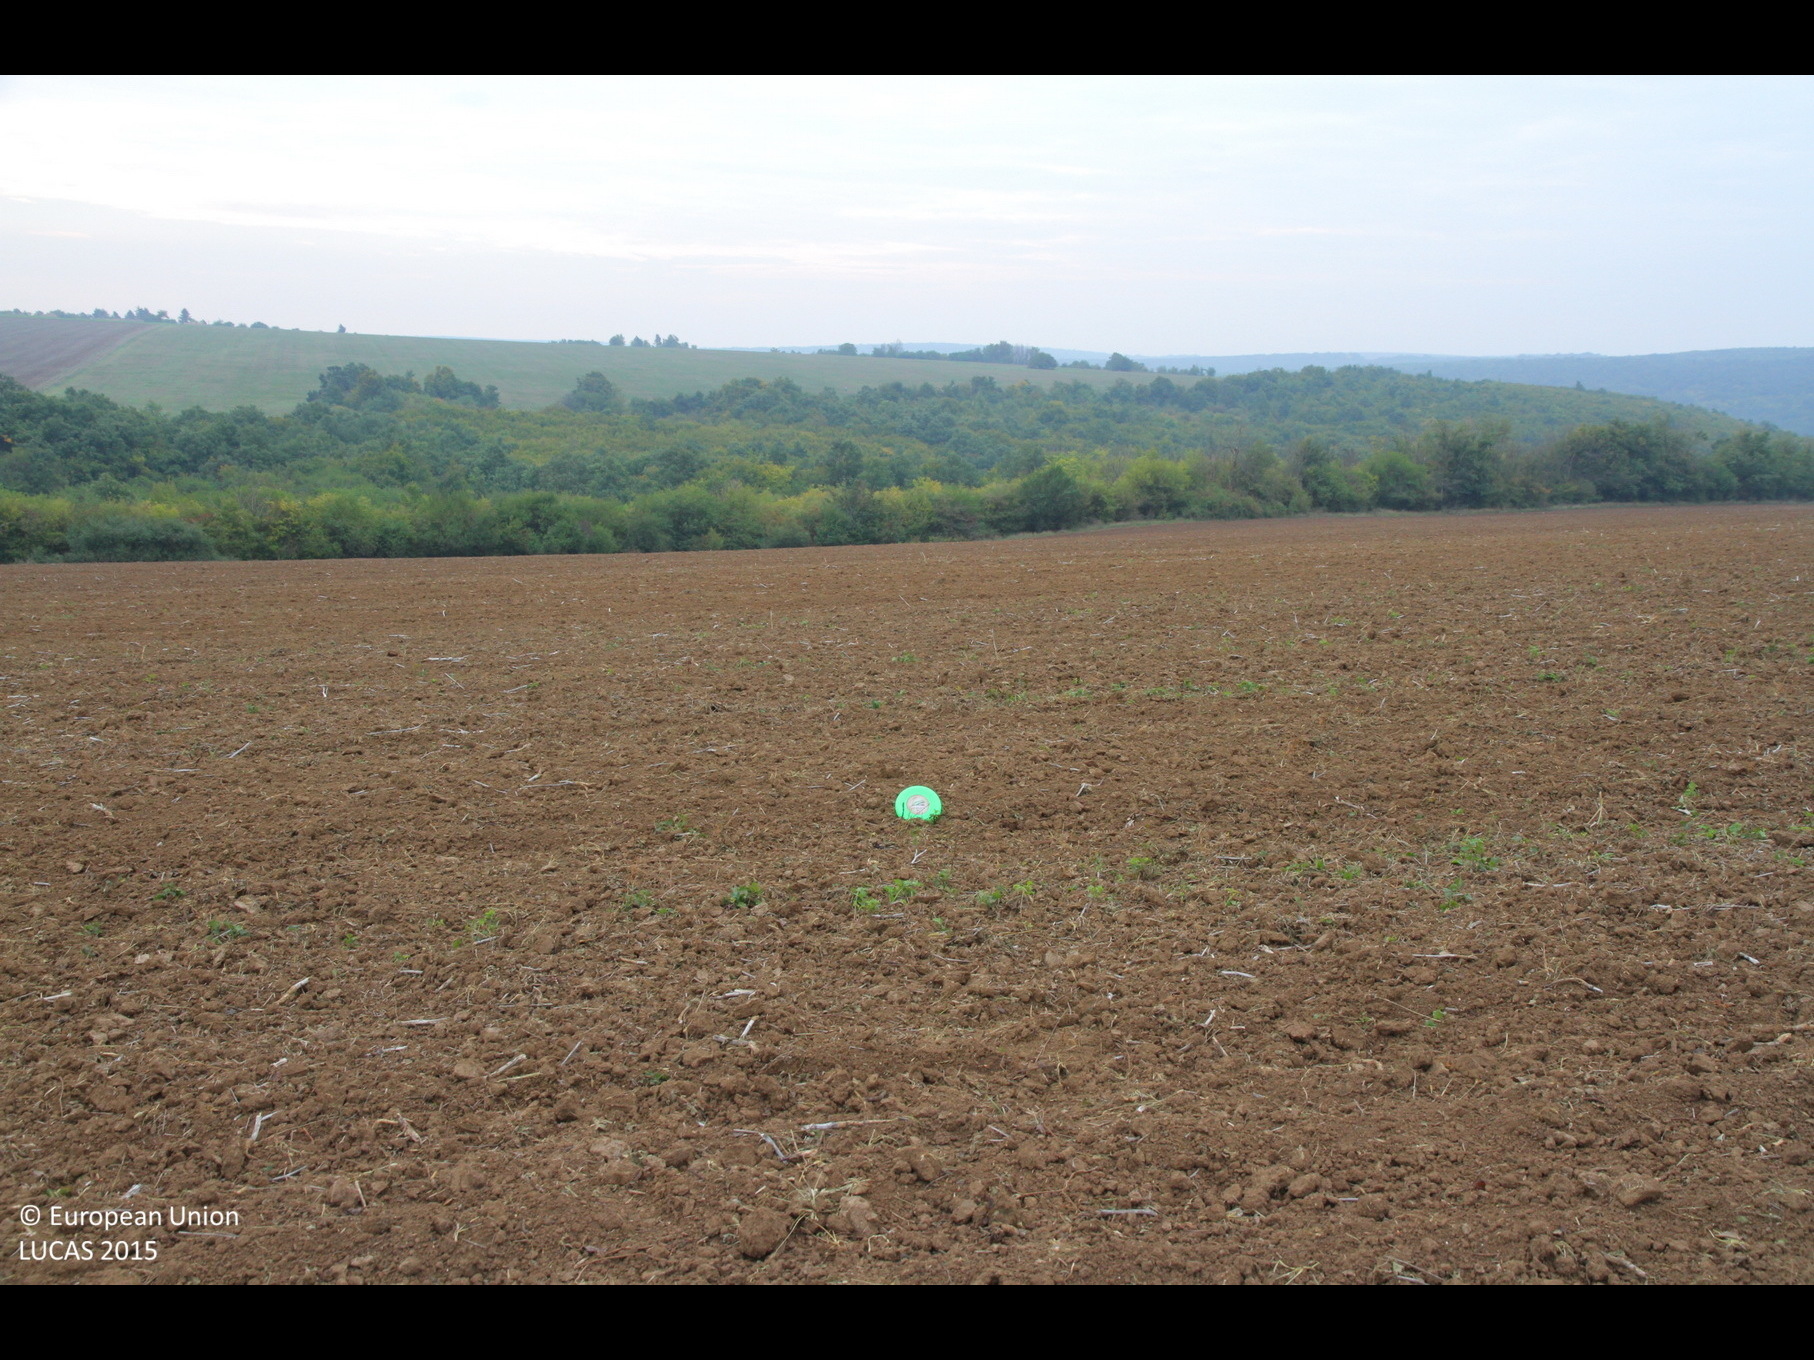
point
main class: Cropland
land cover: Rape and turnip rape
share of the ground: < 10 %
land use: Agriculture (excluding fallow land and kitchen gardens)
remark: Harvested field
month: October
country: BG
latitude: 43.5015
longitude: 27.0249
